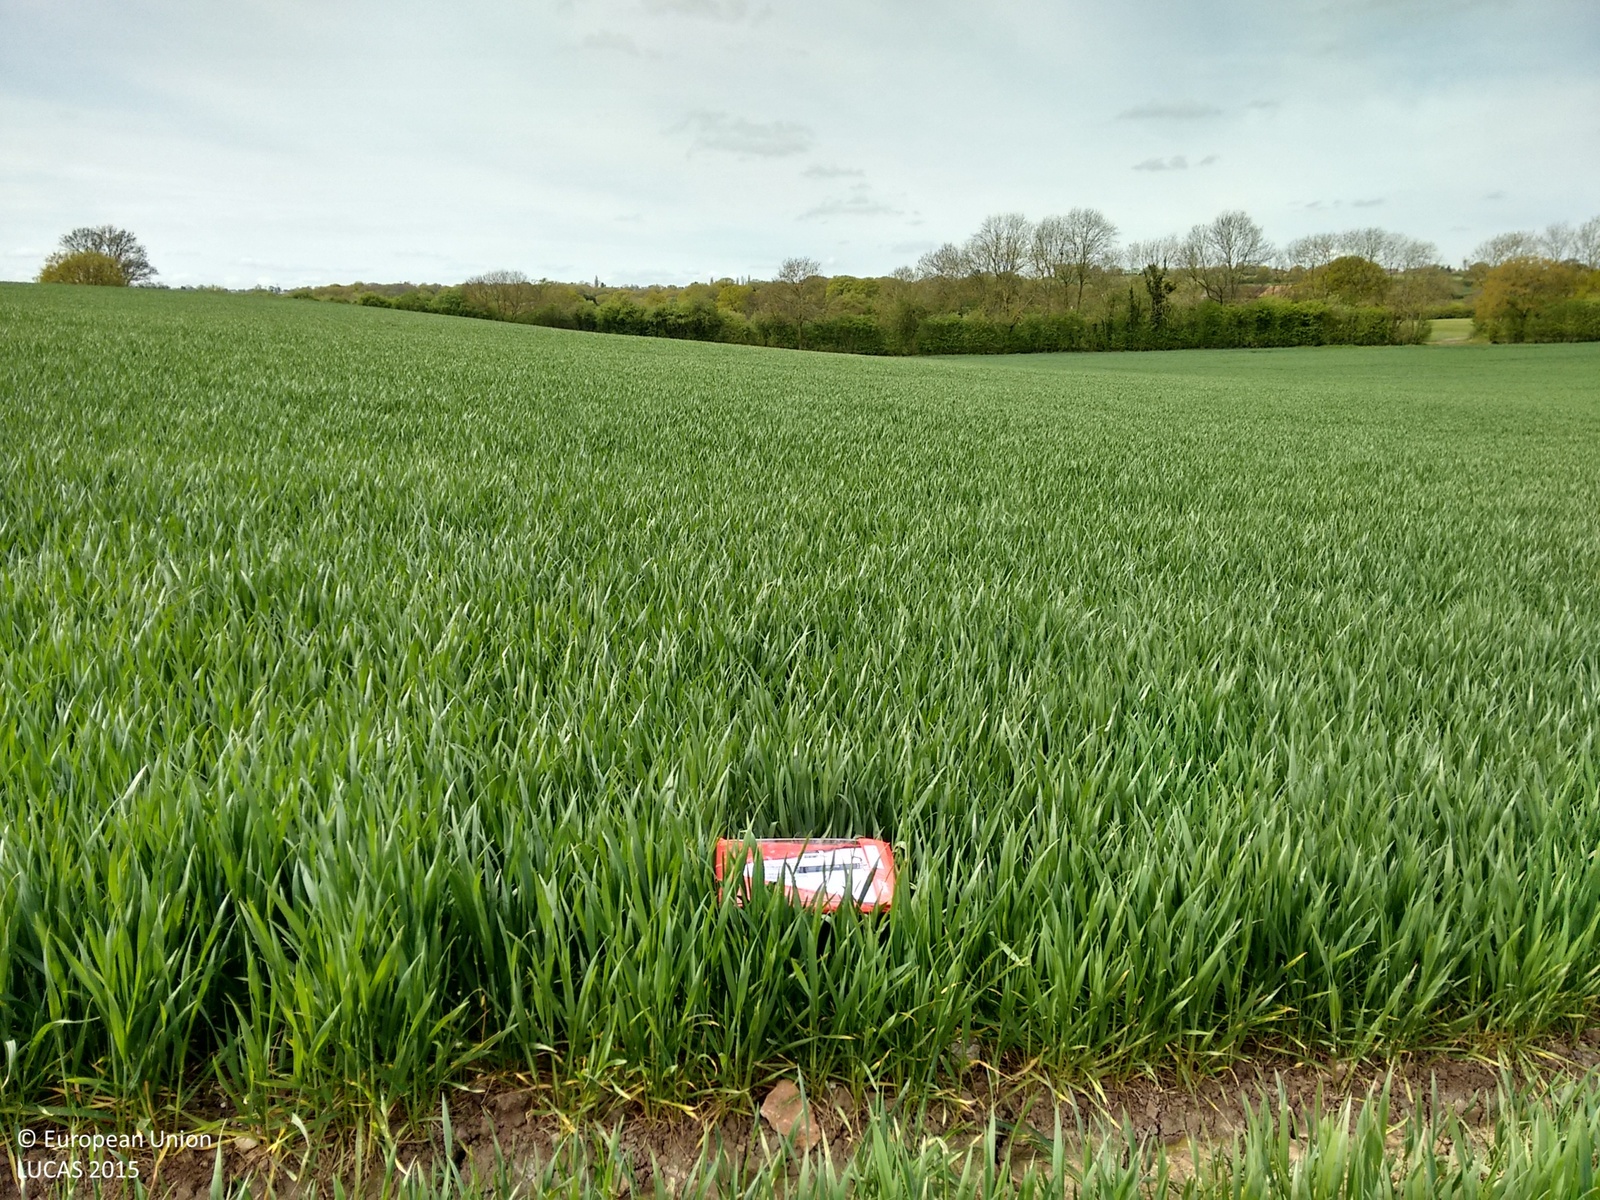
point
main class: Cropland
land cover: Common wheat
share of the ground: > 75 %
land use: Agriculture (excluding fallow land and kitchen gardens)
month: May
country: GB
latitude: 52.2660
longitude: -1.9113
